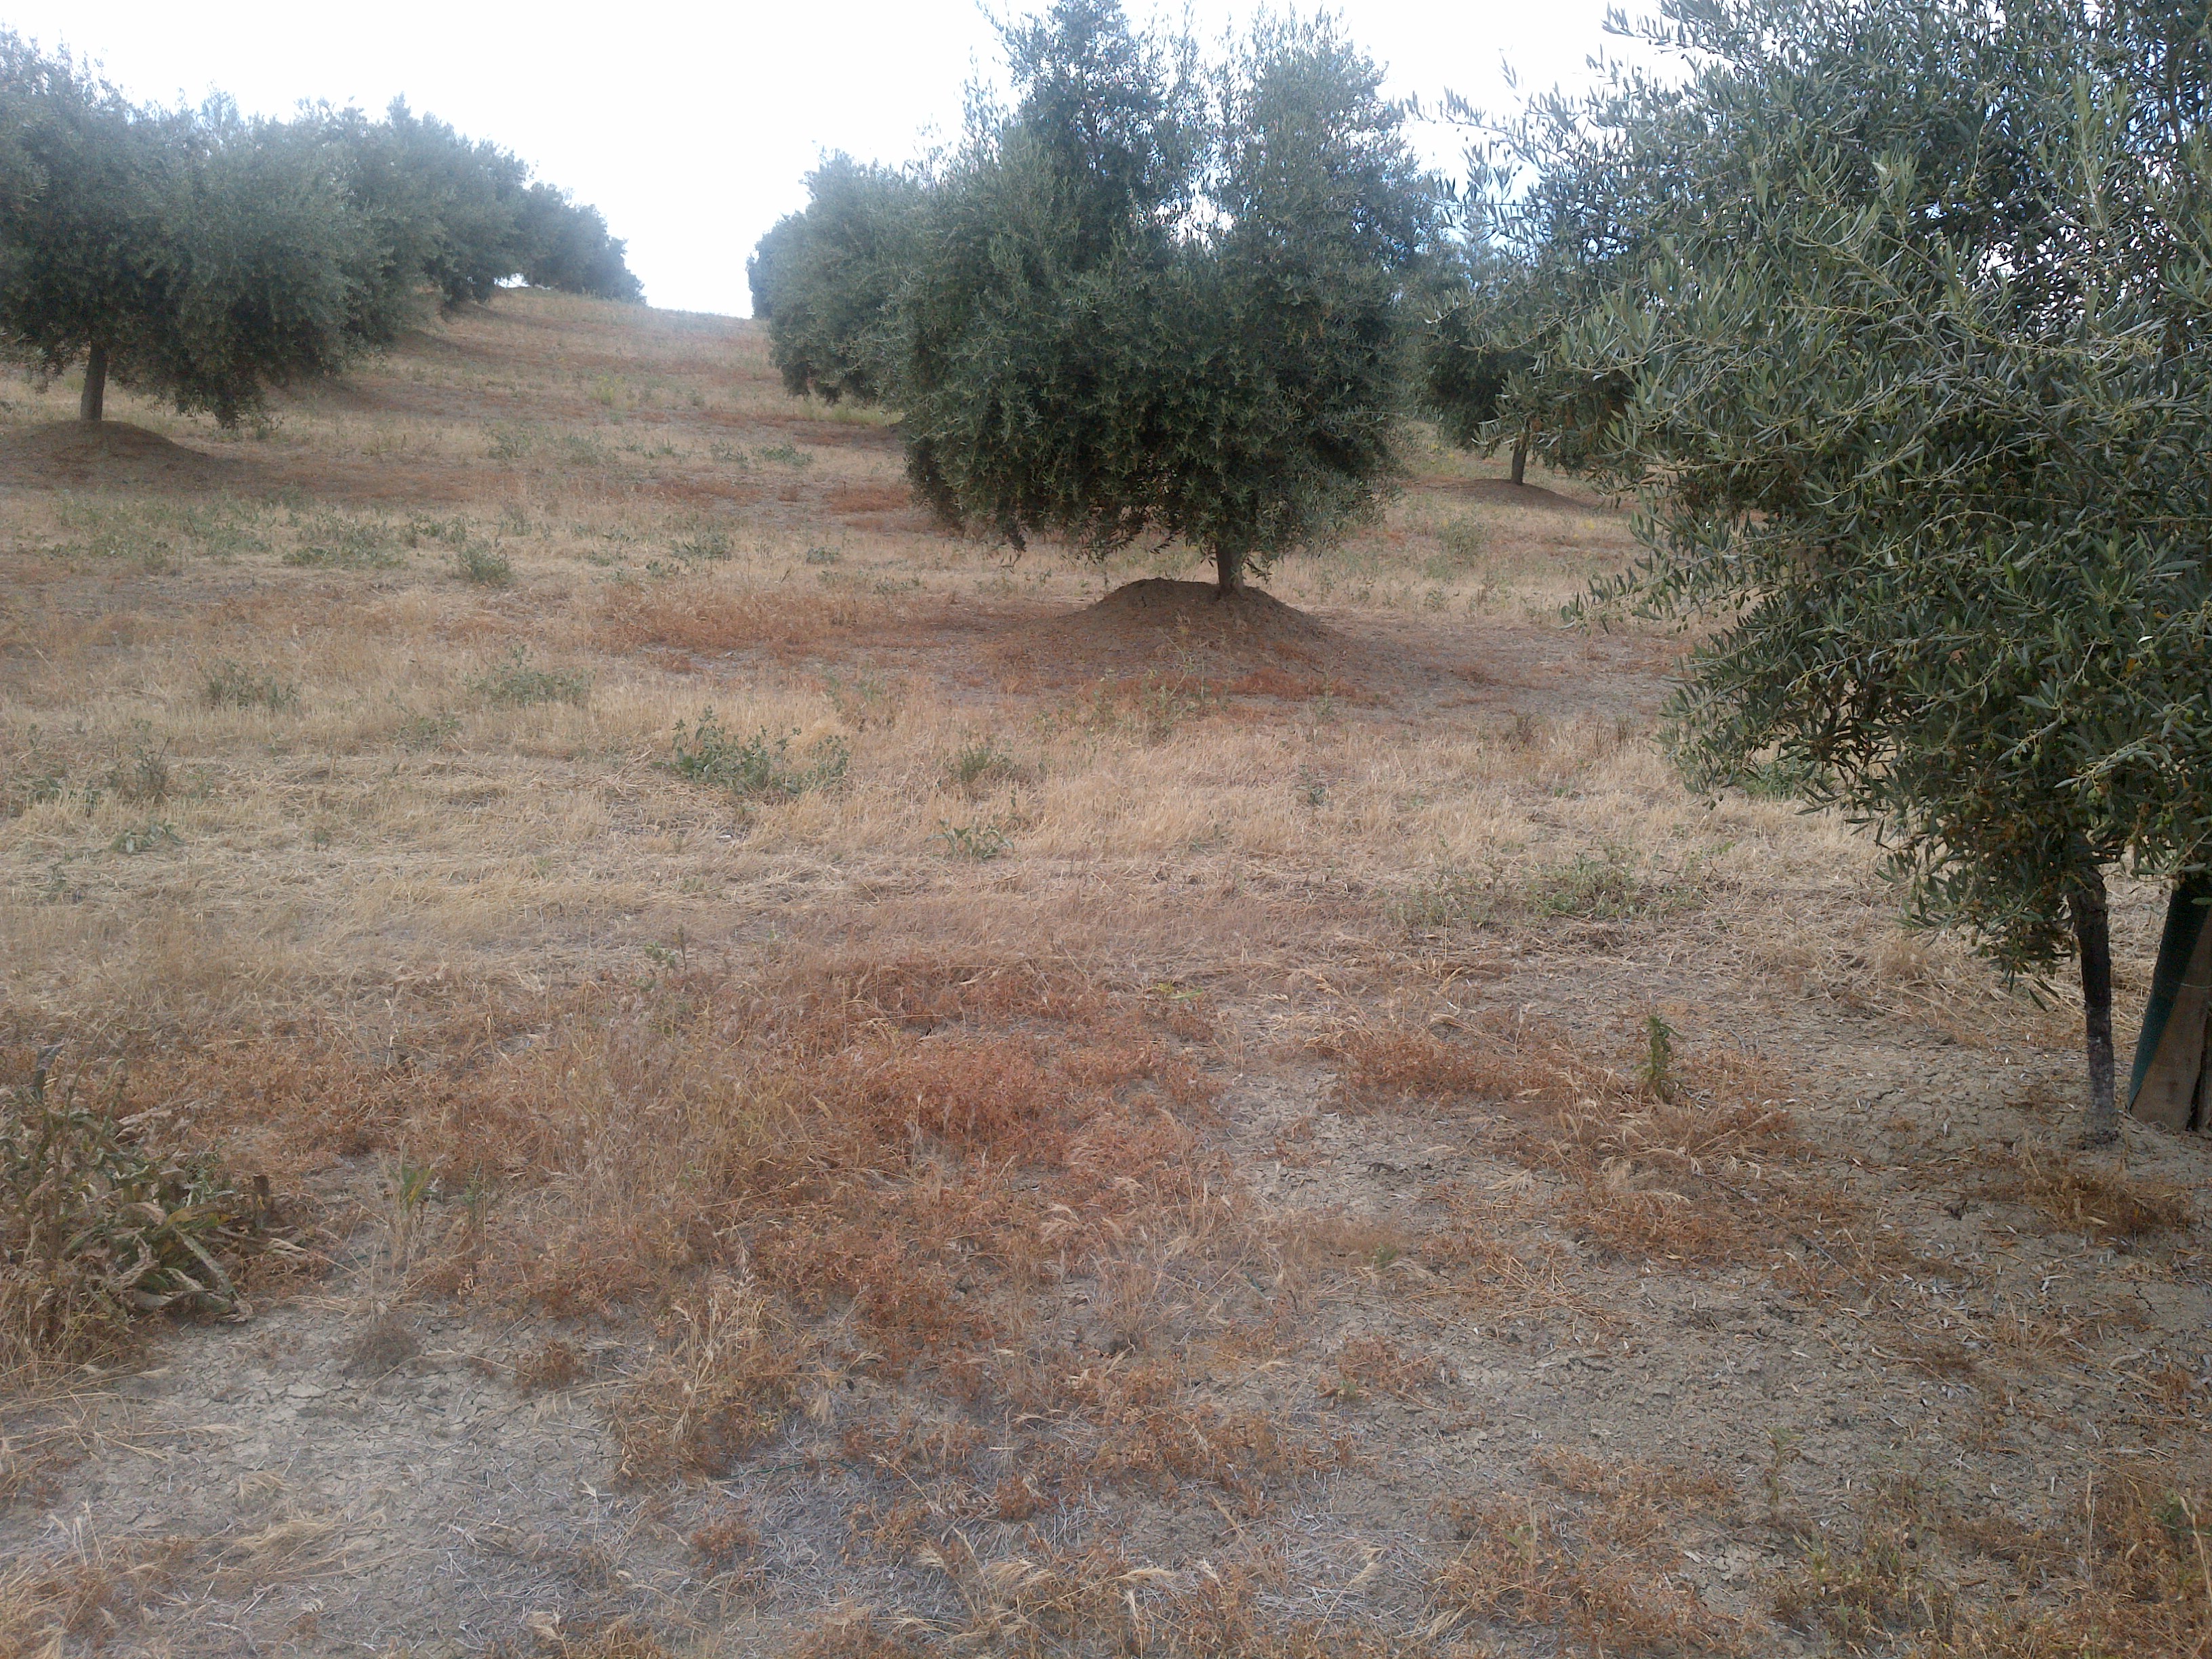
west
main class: Cropland
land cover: Olive groves
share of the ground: 25 - 50 %
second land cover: Spontaneously vegetated surfaces
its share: 10 - 25 %
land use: Agriculture (excluding fallow land and kitchen gardens)
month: June
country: ES
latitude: 37.8384
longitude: -4.2907
